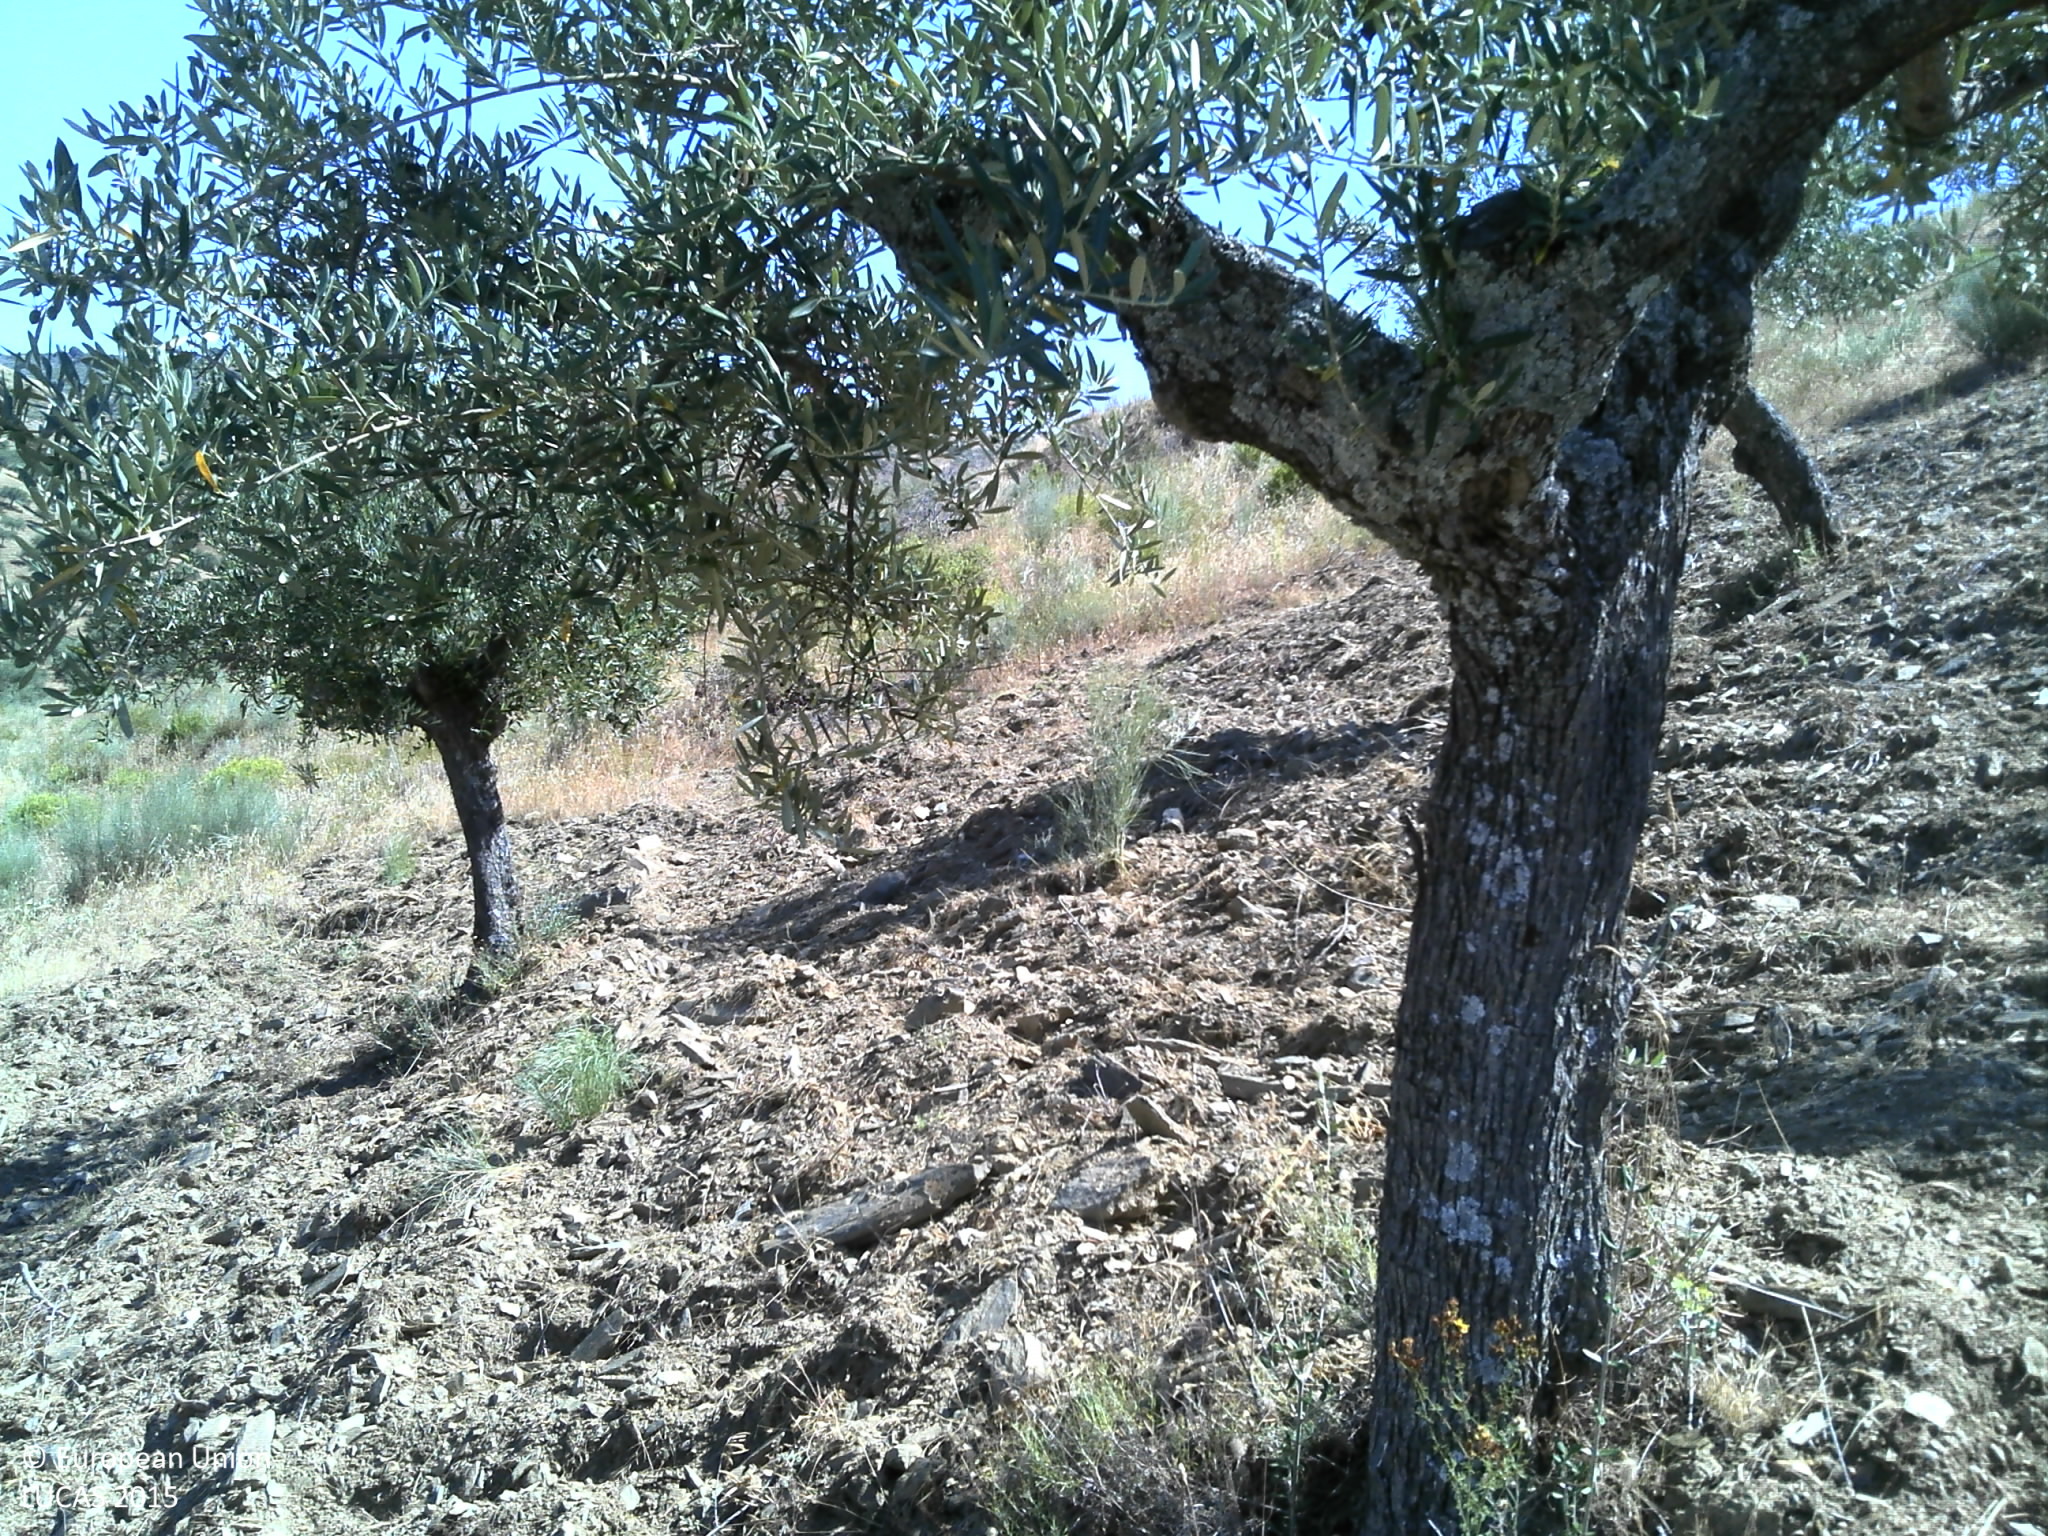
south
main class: Cropland
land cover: Olive groves
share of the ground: < 10 %
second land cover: Other bare soil
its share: > 75 %
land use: Agriculture (excluding fallow land and kitchen gardens)
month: June
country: PT
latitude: 41.0057
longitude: -6.9776
